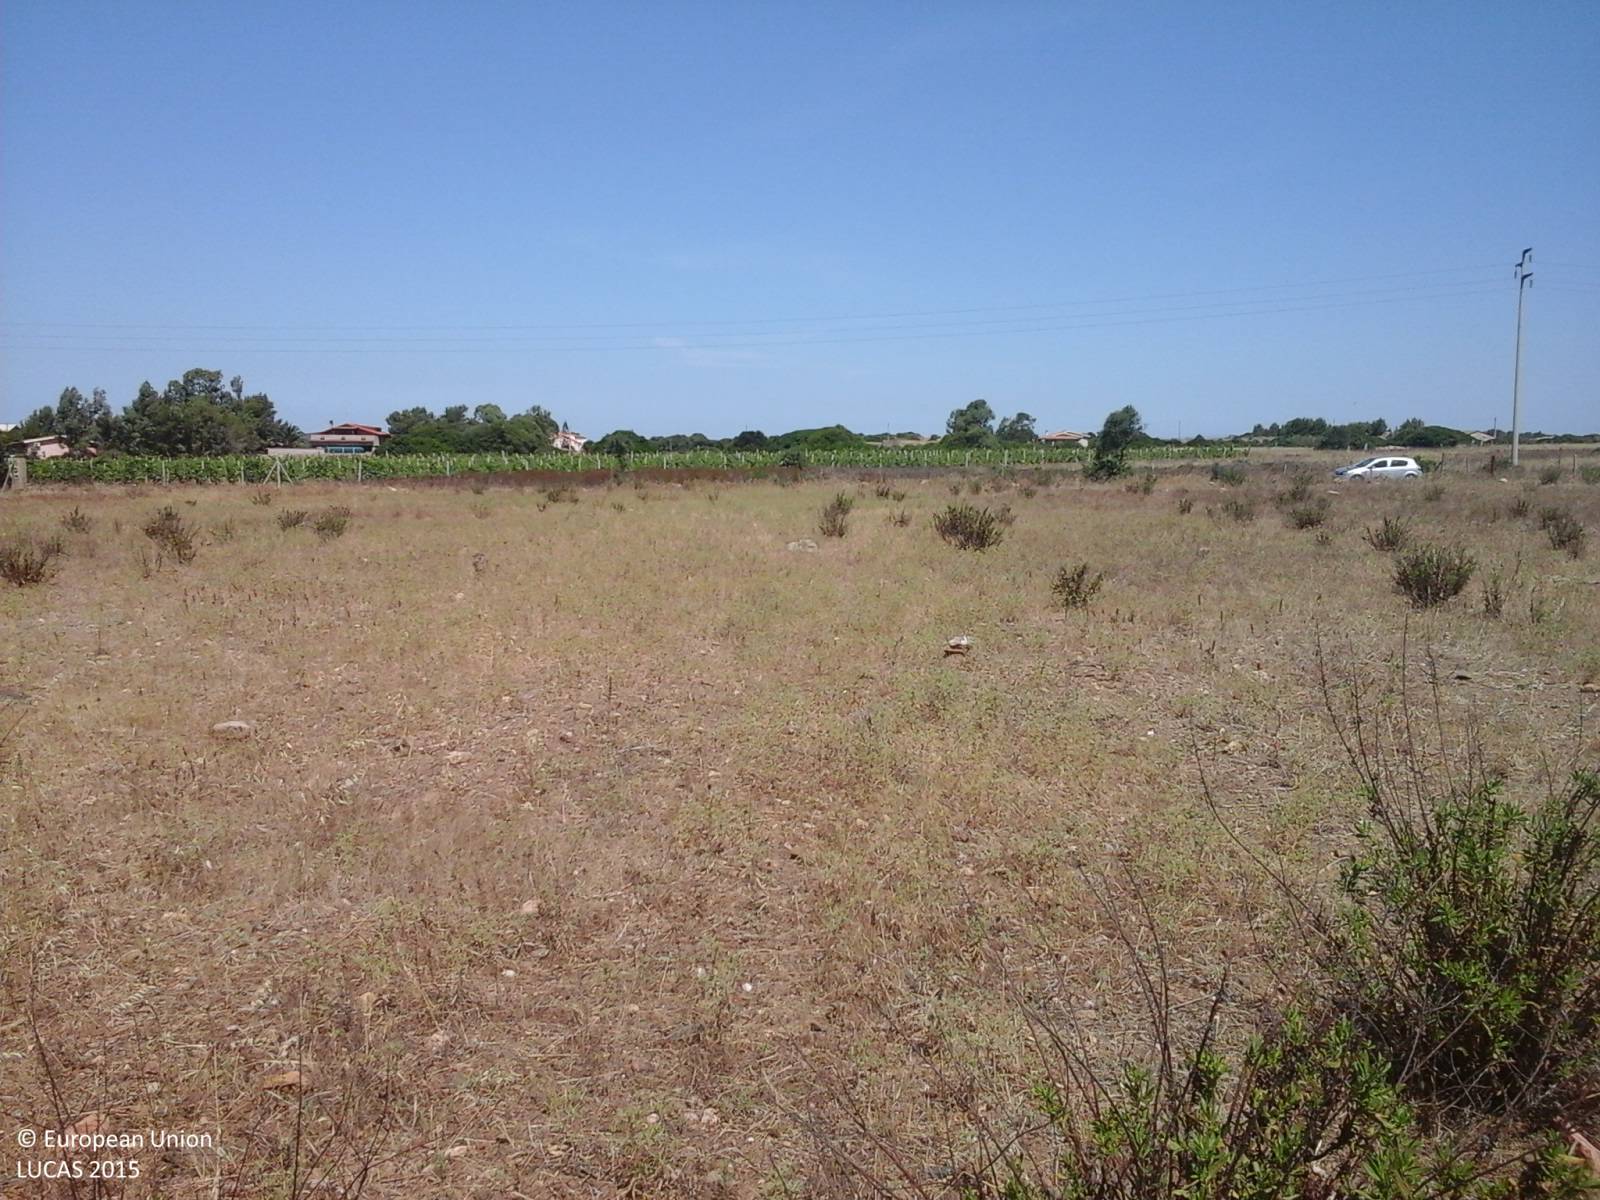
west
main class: Grassland
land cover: Grassland without tree/shrub cover
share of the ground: > 75 %
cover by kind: herbaceous plants 95 %, shrubs 5 %
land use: Agriculture (excluding fallow land and kitchen gardens)
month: June
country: IT
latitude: 38.9896
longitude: 8.6349
